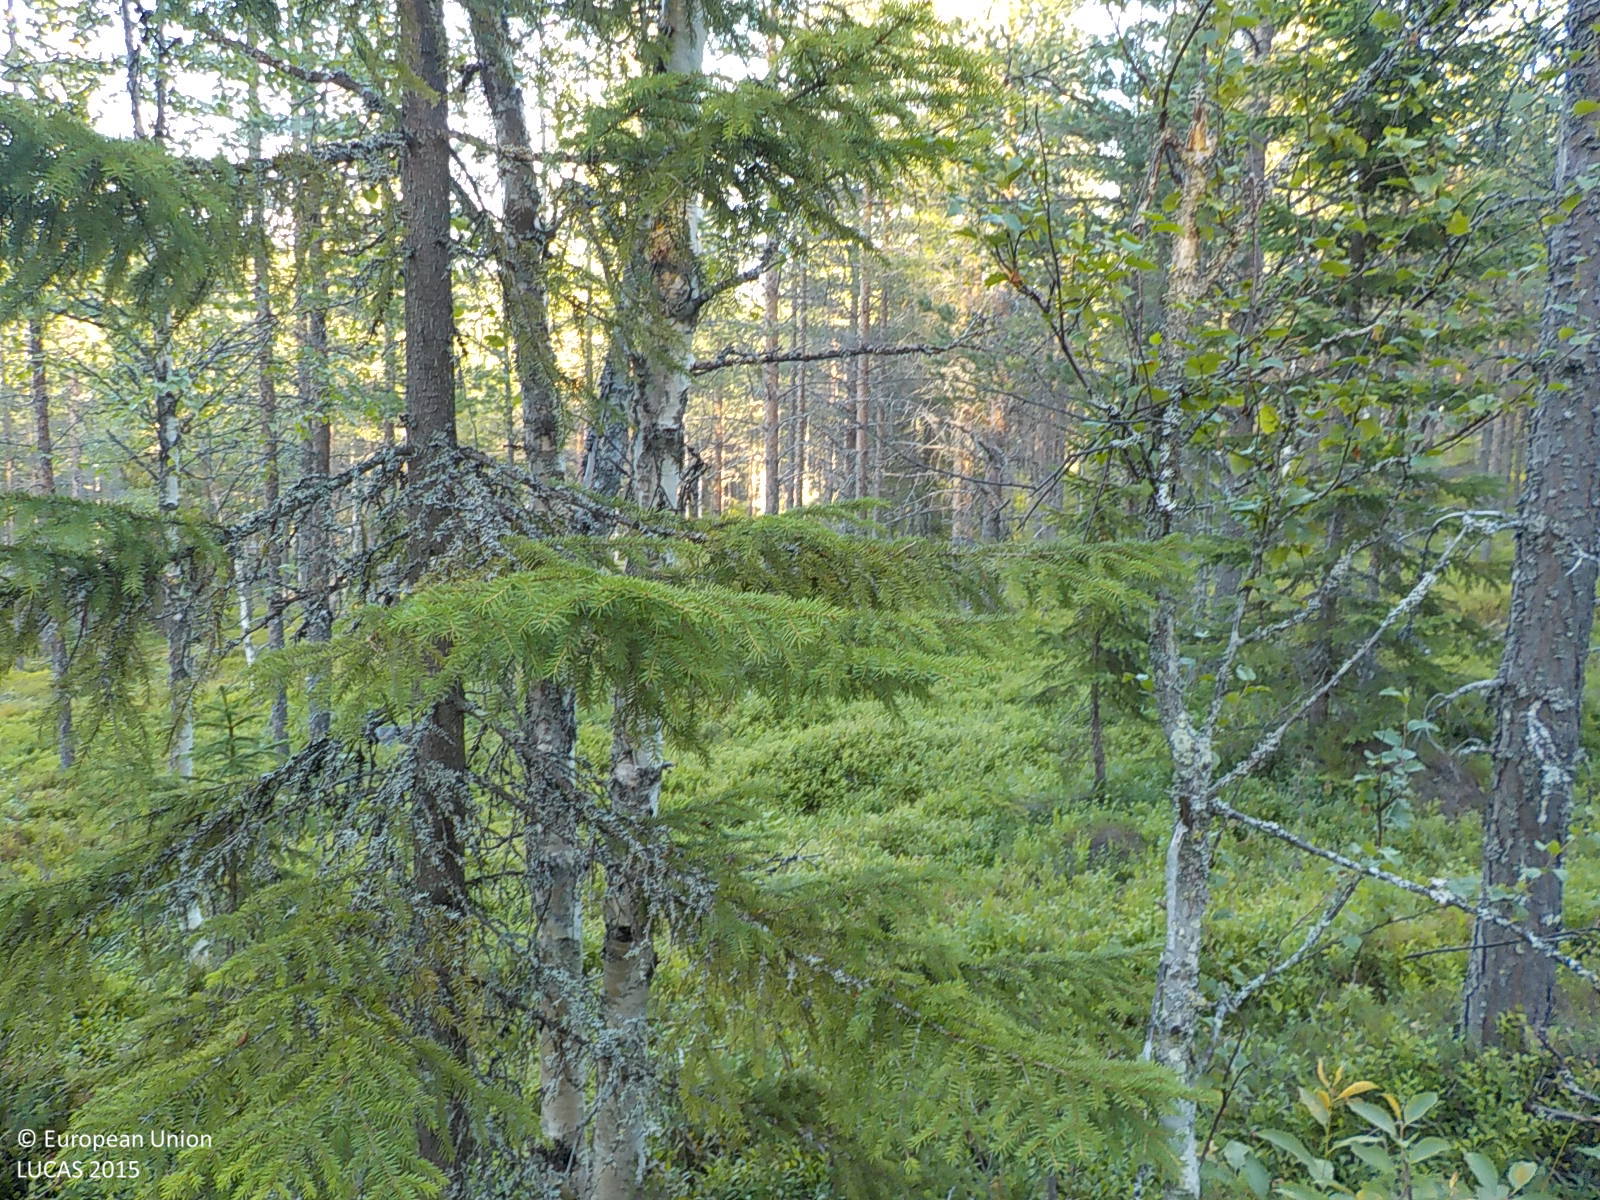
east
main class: Woodland
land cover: Pine dominated coniferous woodland
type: boreal forest
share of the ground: 50 - 75 %
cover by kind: coniferous forest trees 50 %, shrubs 30 %, herbaceous plants 10 %, lichens and mosses 10 %
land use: Forestry
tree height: > 5 m
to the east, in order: Pine dominated coniferous woodland; Shrubland without tree cover; Other mixed woodland; Ditches and canals; Broadleaved woodland; Paved roads, cycling and walking lanes; Broadleaved woodland; Ditches and canals; Pine dominated mixed woodland; Pine dominated coniferous woodland
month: August
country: SE
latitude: 63.4703
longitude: 18.6658
